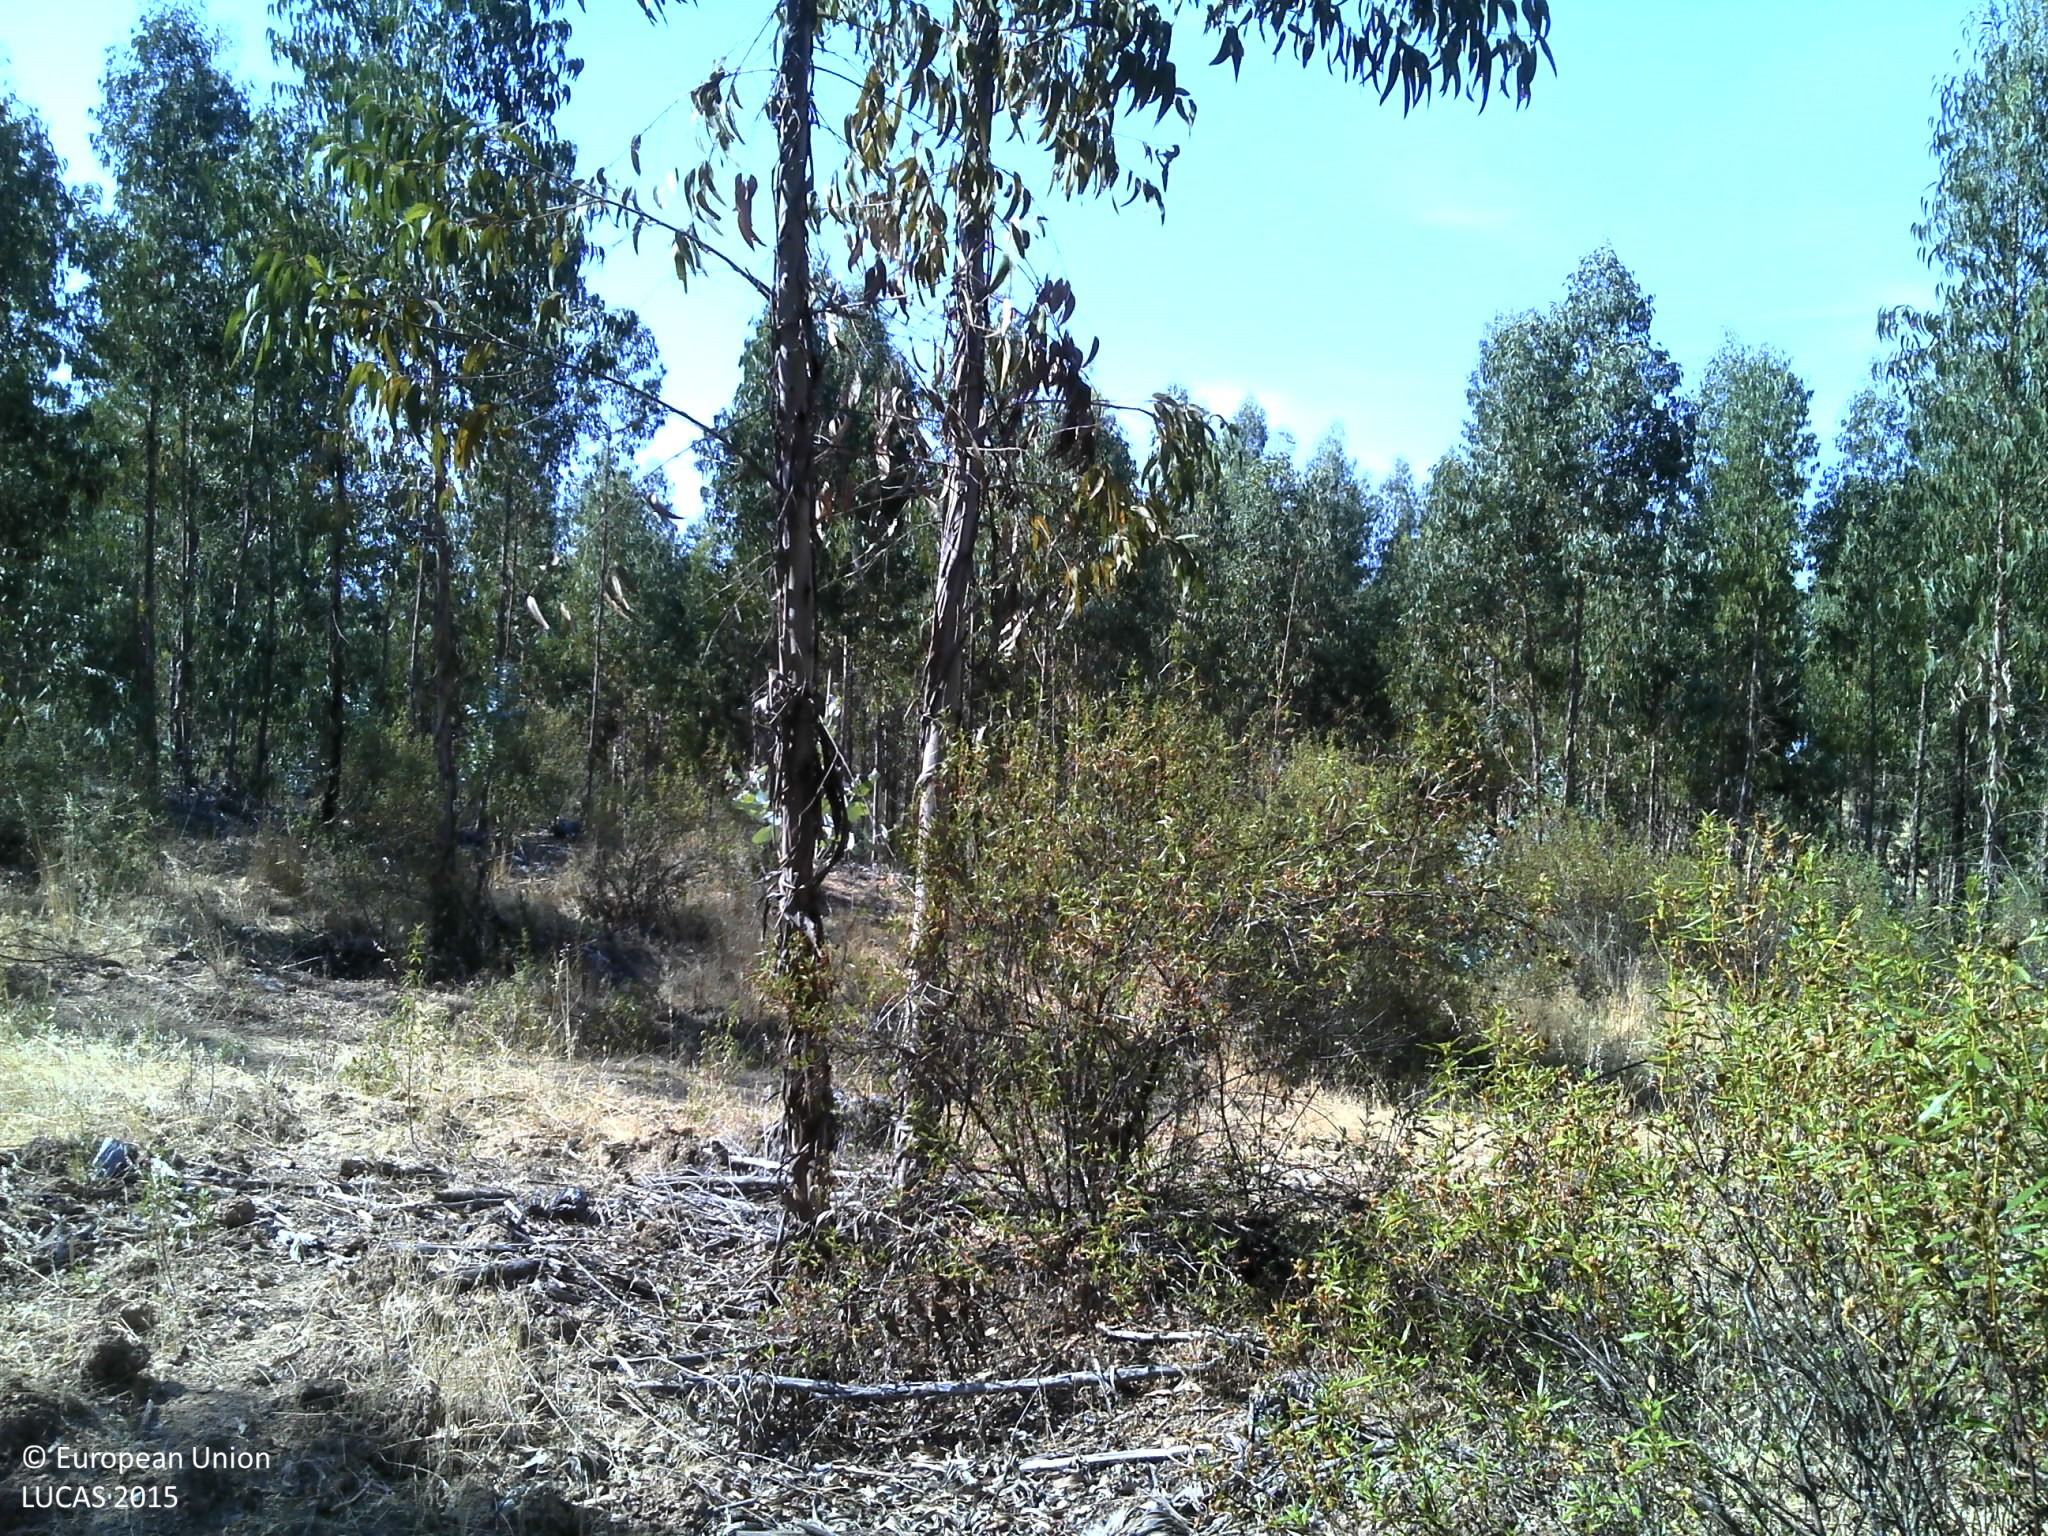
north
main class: Woodland
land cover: Broadleaved woodland
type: exotic forest
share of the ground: 50 - 75 %
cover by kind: broadleaved forest trees 75 %, shrubs 15 %, unconsolidated bare surface 10 %
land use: Forestry
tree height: > 5 m
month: July
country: PT
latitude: 38.7346
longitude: -7.5074
